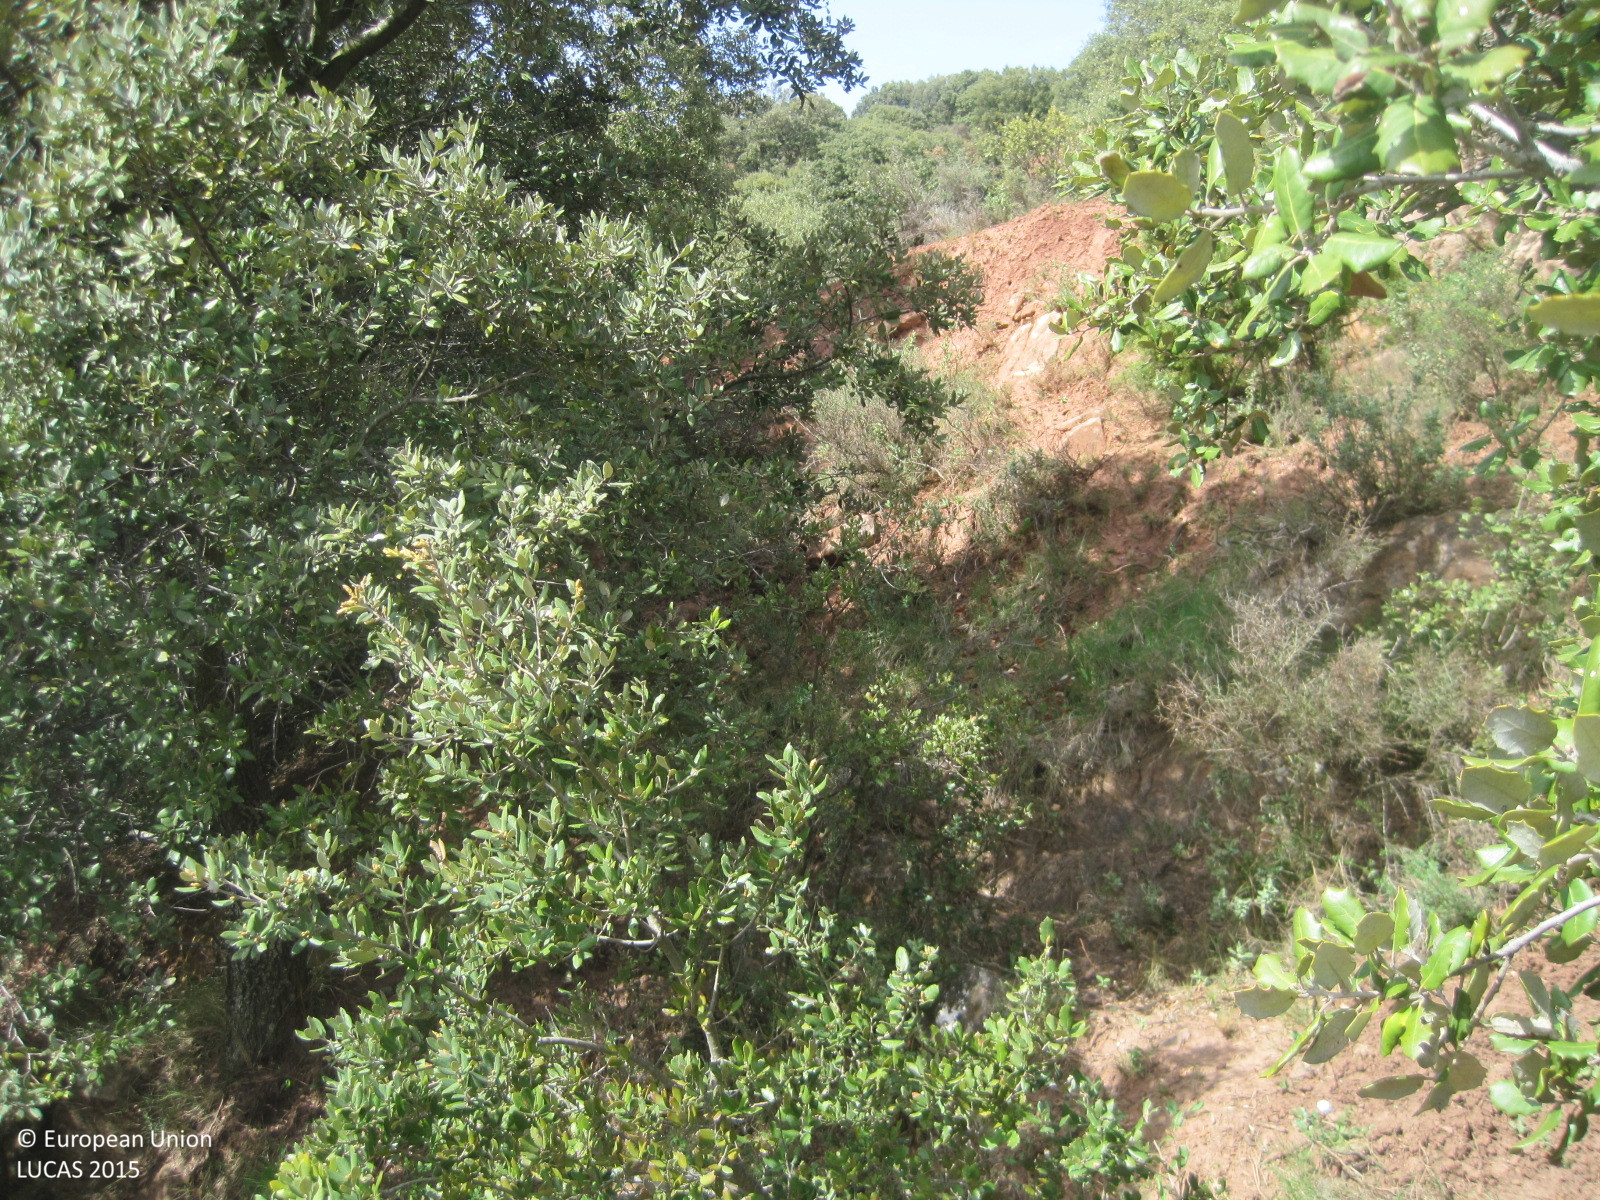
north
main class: Woodland
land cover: Broadleaved woodland
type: broadleaved evergreen forest
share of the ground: 50 - 75 %
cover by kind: broadleaved forest trees 50 %, shrubs 30 %, unconsolidated bare surface 15 %, consolidated bare surface 5 %
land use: Semi-natural and natural areas not in use
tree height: > 5 m
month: April
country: ES
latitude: 42.6133
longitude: -2.2959
